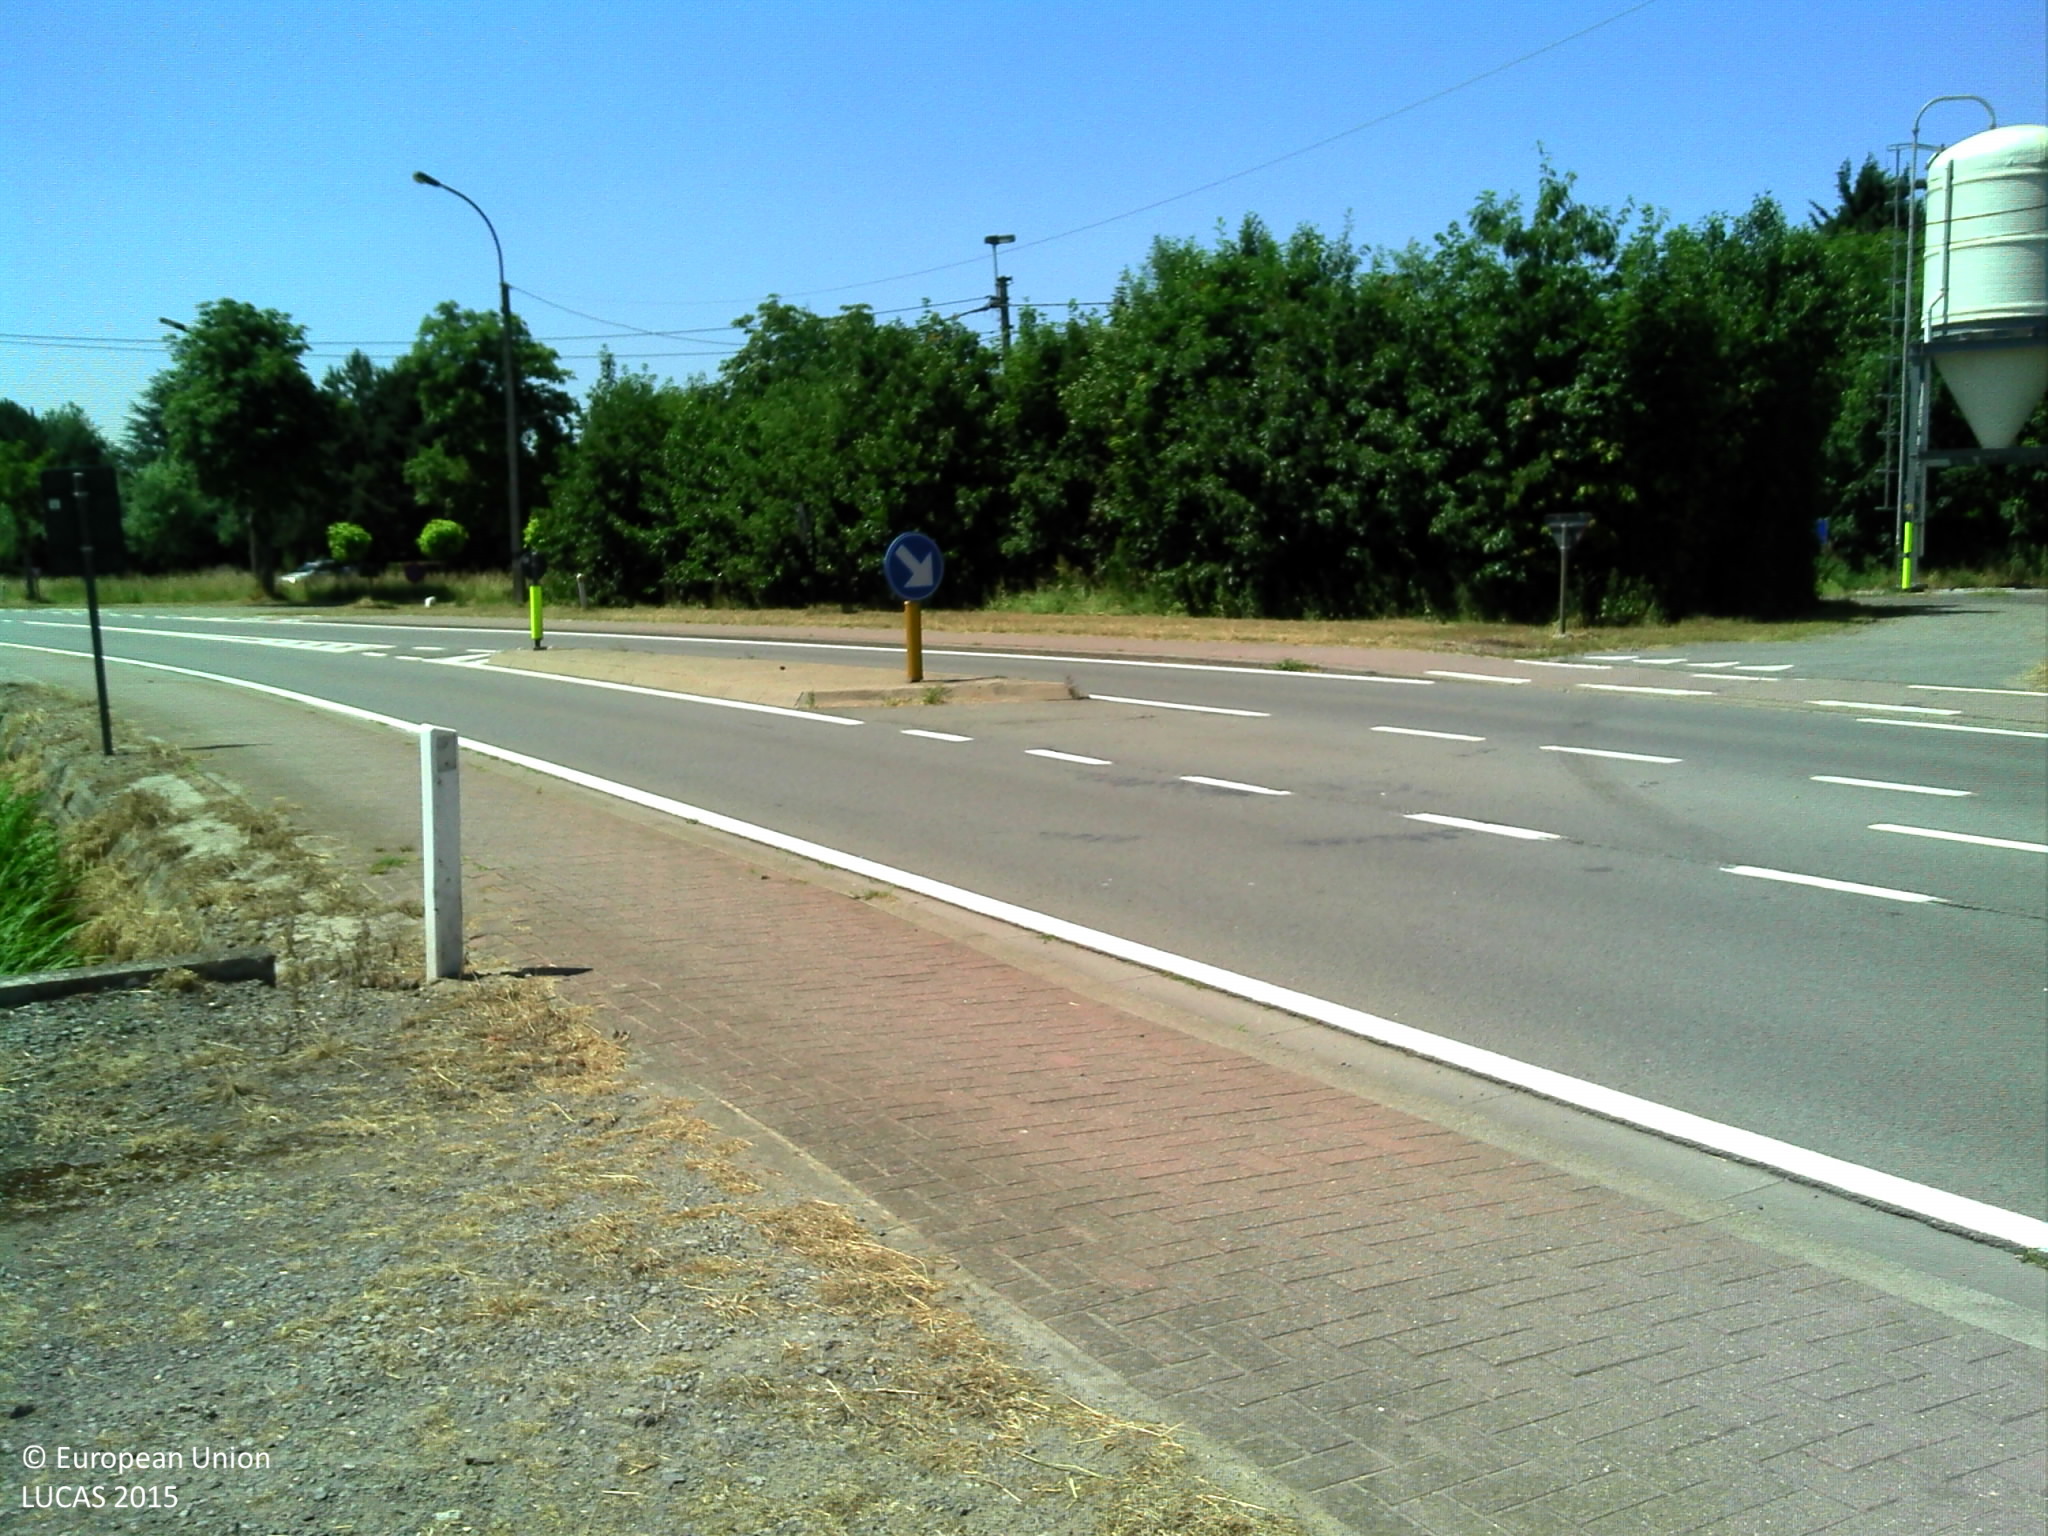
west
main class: Grassland
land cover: Grassland without tree/shrub cover
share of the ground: > 75 %
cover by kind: herbaceous plants 100 %
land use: Agriculture (excluding fallow land and kitchen gardens)
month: June
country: BE
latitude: 51.2040
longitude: 3.7672
